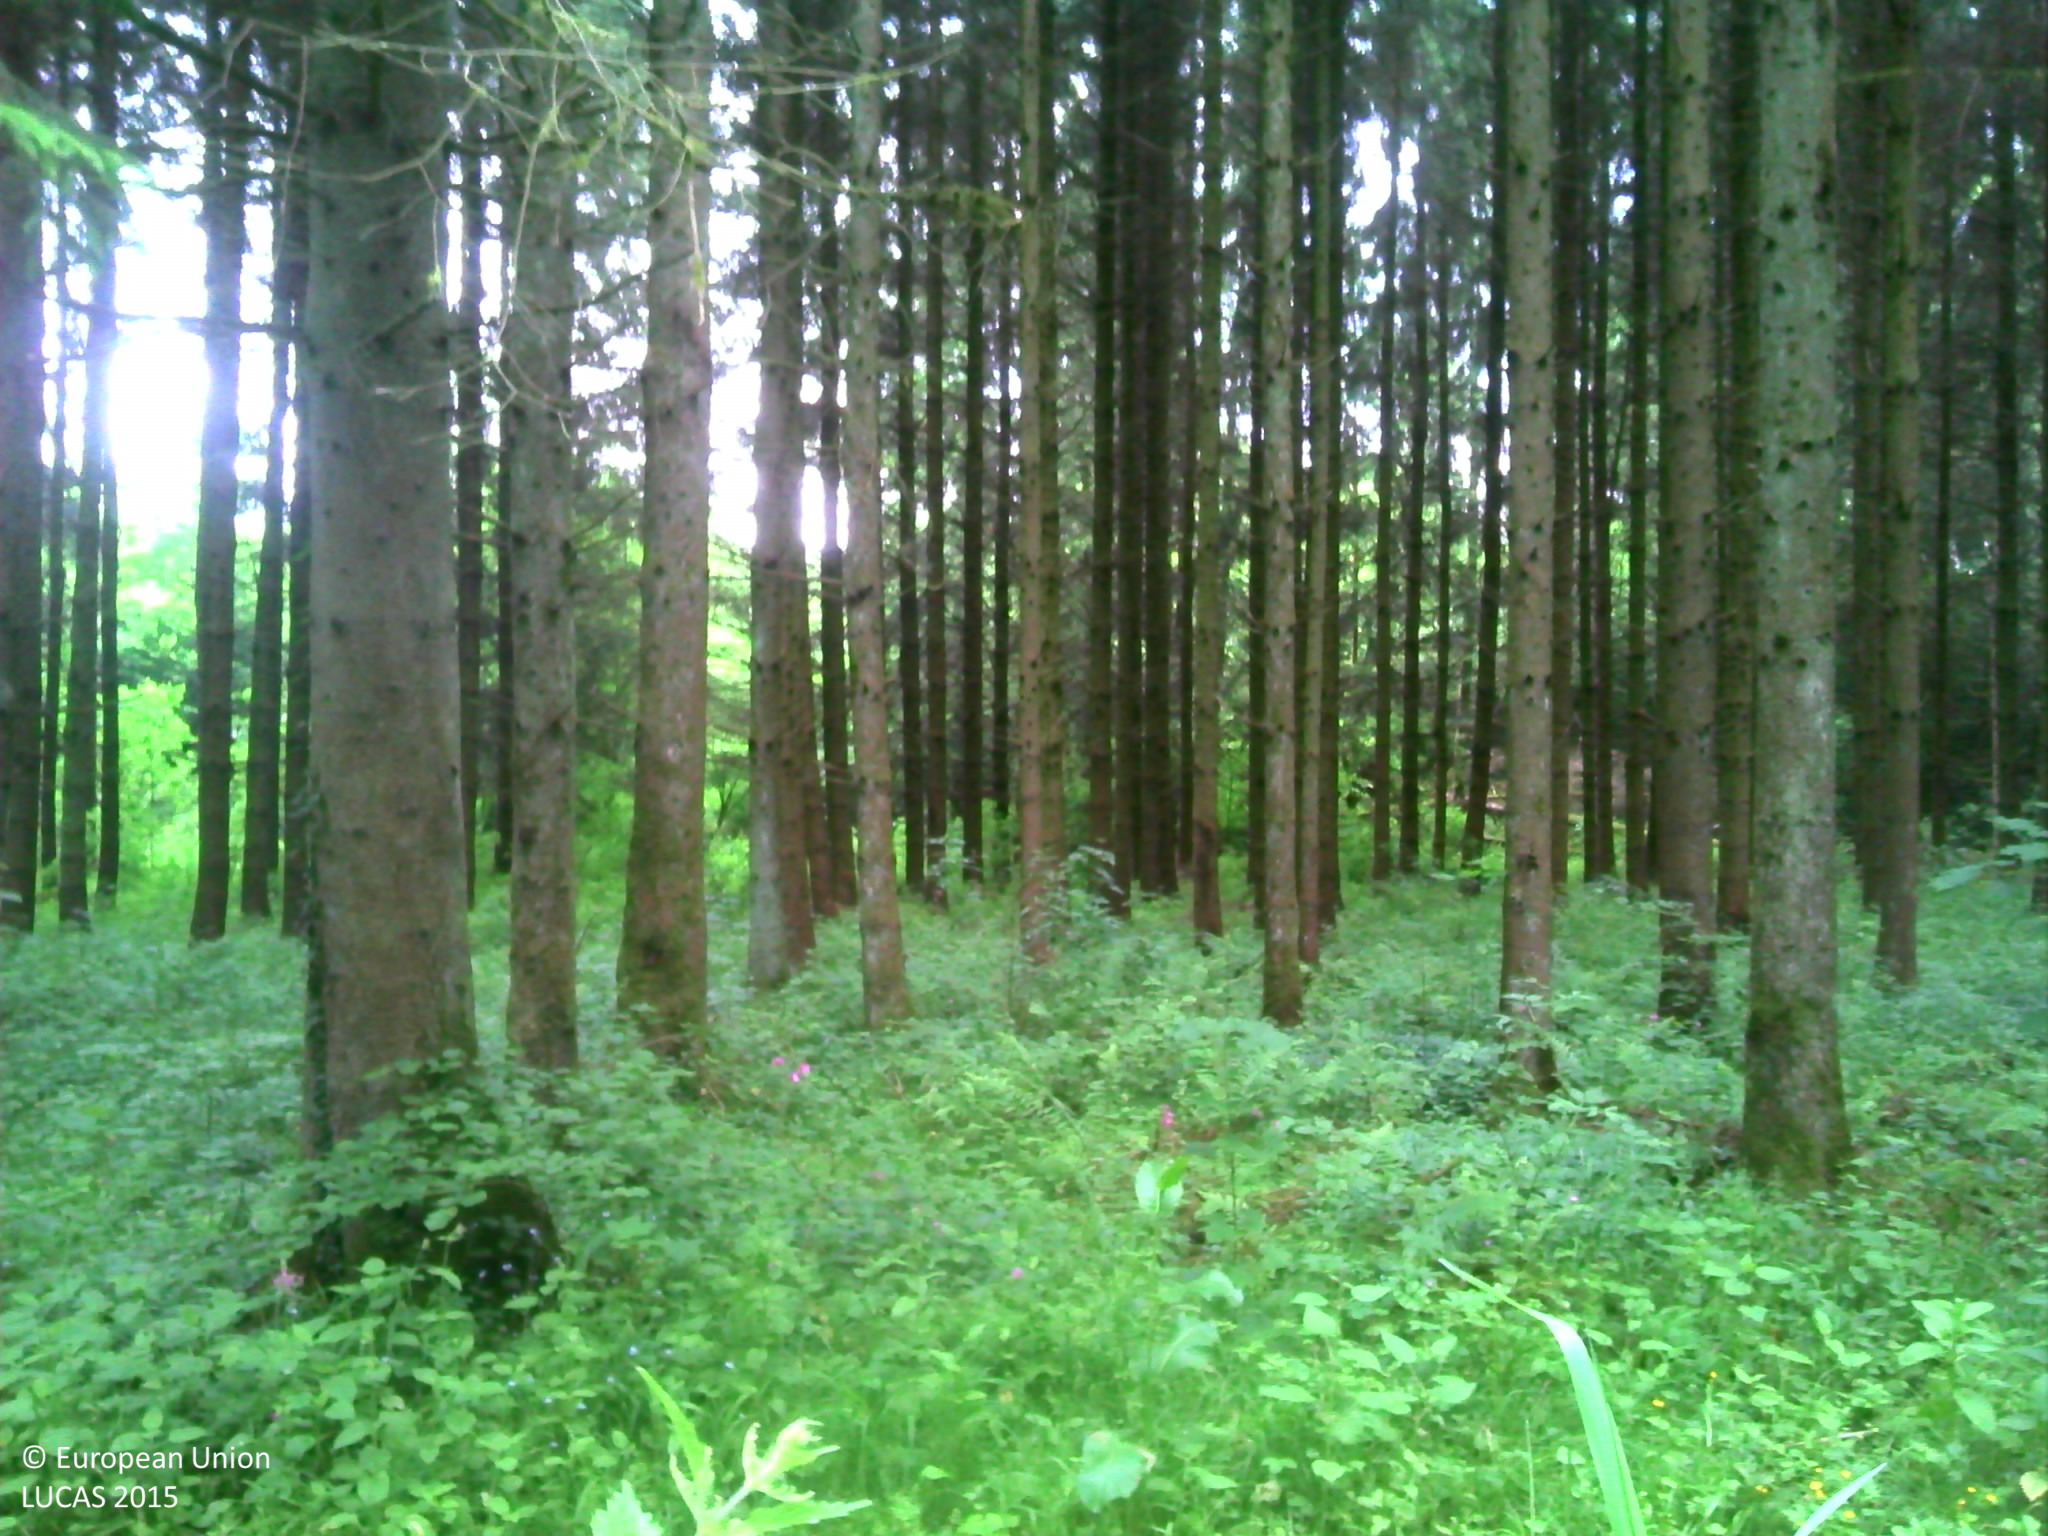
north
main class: Grassland
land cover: Spontaneously vegetated surfaces
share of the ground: > 75 %
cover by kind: herbaceous plants 100 %
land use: Forestry
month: June
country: BE
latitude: 50.2430
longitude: 4.7383
